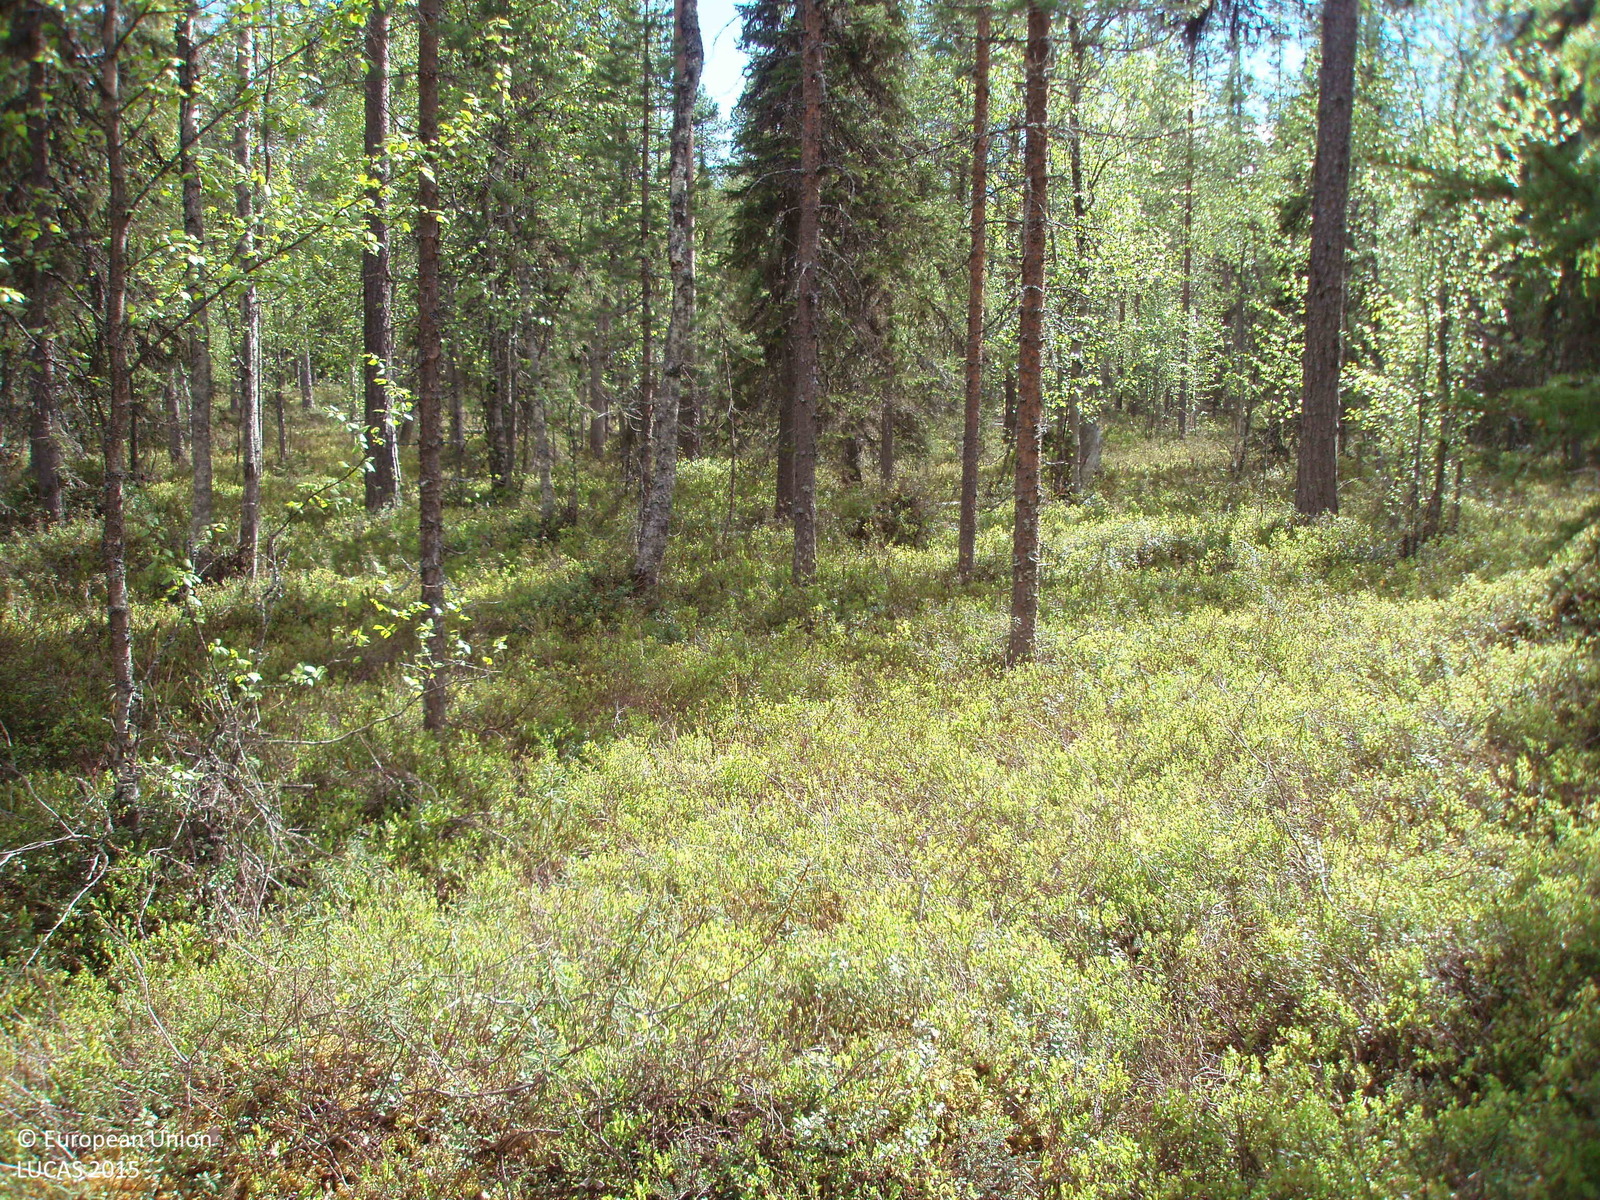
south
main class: Woodland
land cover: Other mixed woodland
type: boreal forest
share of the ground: 50 - 75 %
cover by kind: coniferous forest trees 40 %, broadleaved forest trees 30 %, shrubs 30 %
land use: Forestry
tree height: > 5 m
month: June
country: FI
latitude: 67.0409
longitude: 27.2124
